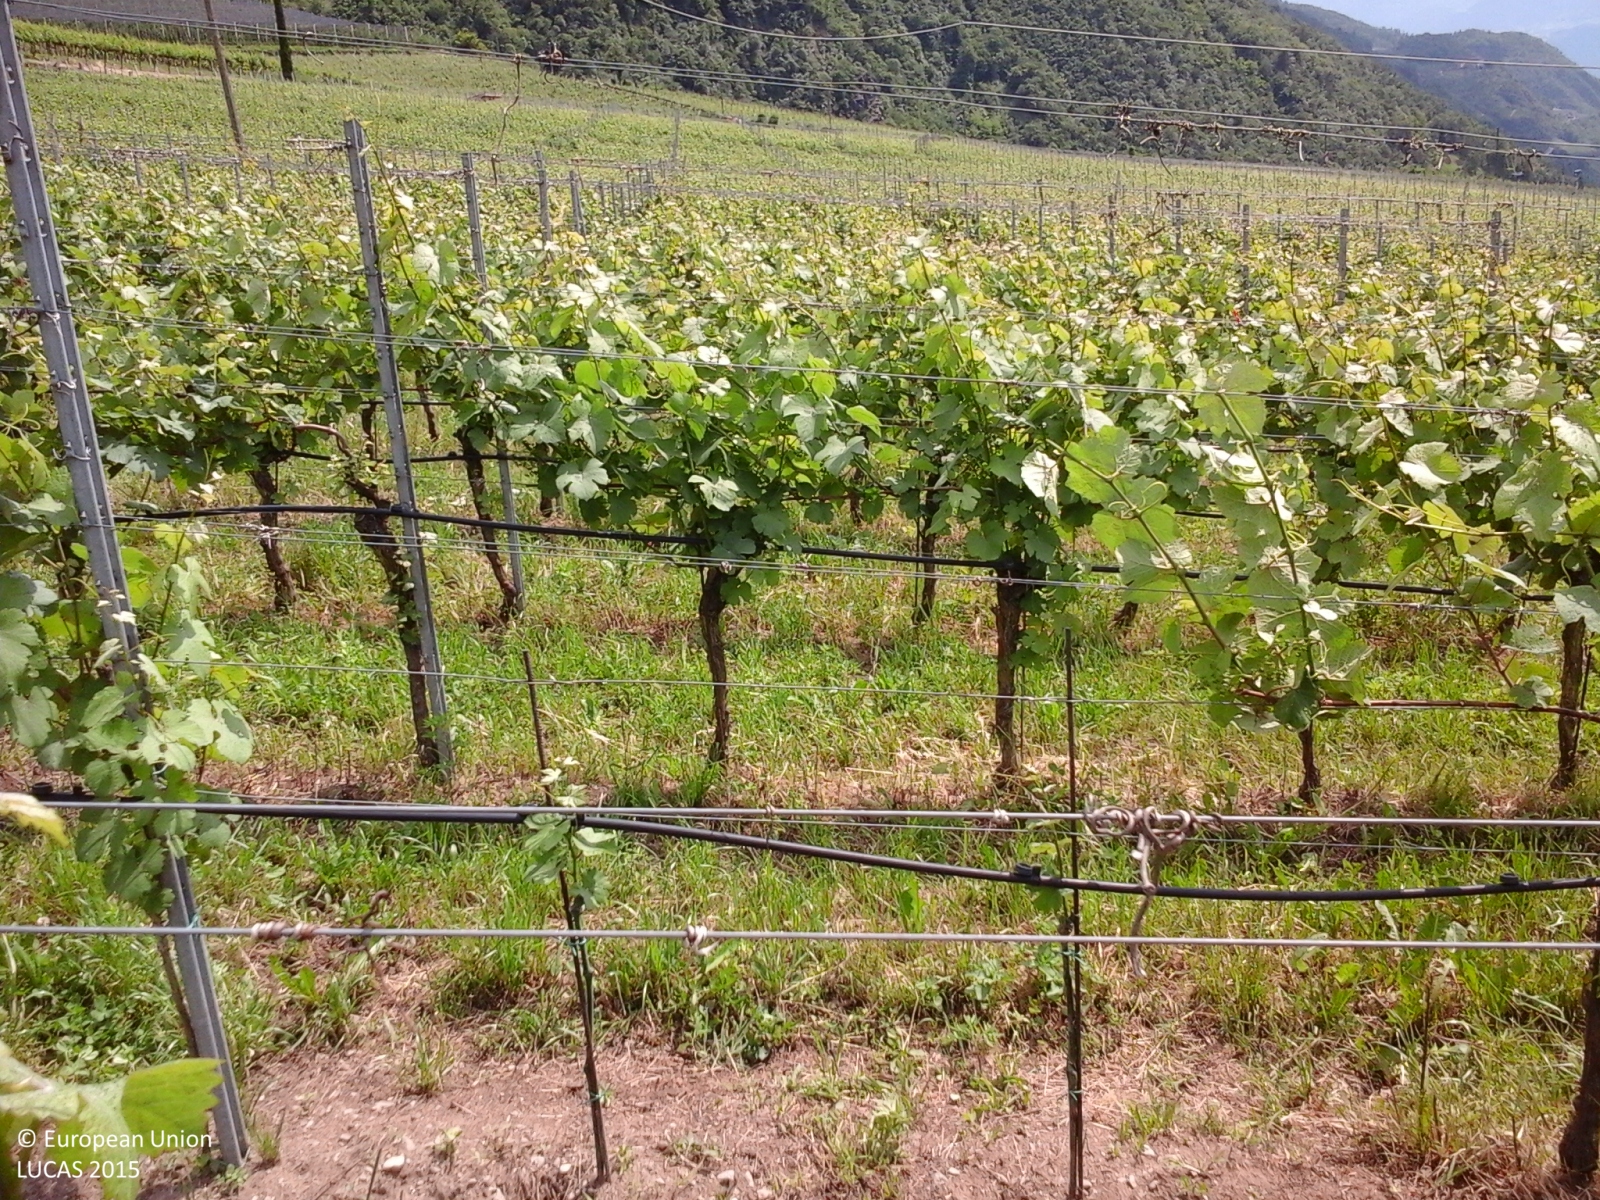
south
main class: Cropland
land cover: Vineyards
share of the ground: 50 - 75 %
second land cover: Grassland without tree/shrub cover
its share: > 75 %
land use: Agriculture (excluding fallow land and kitchen gardens)
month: May
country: IT
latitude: 46.6688
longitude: 11.1881
